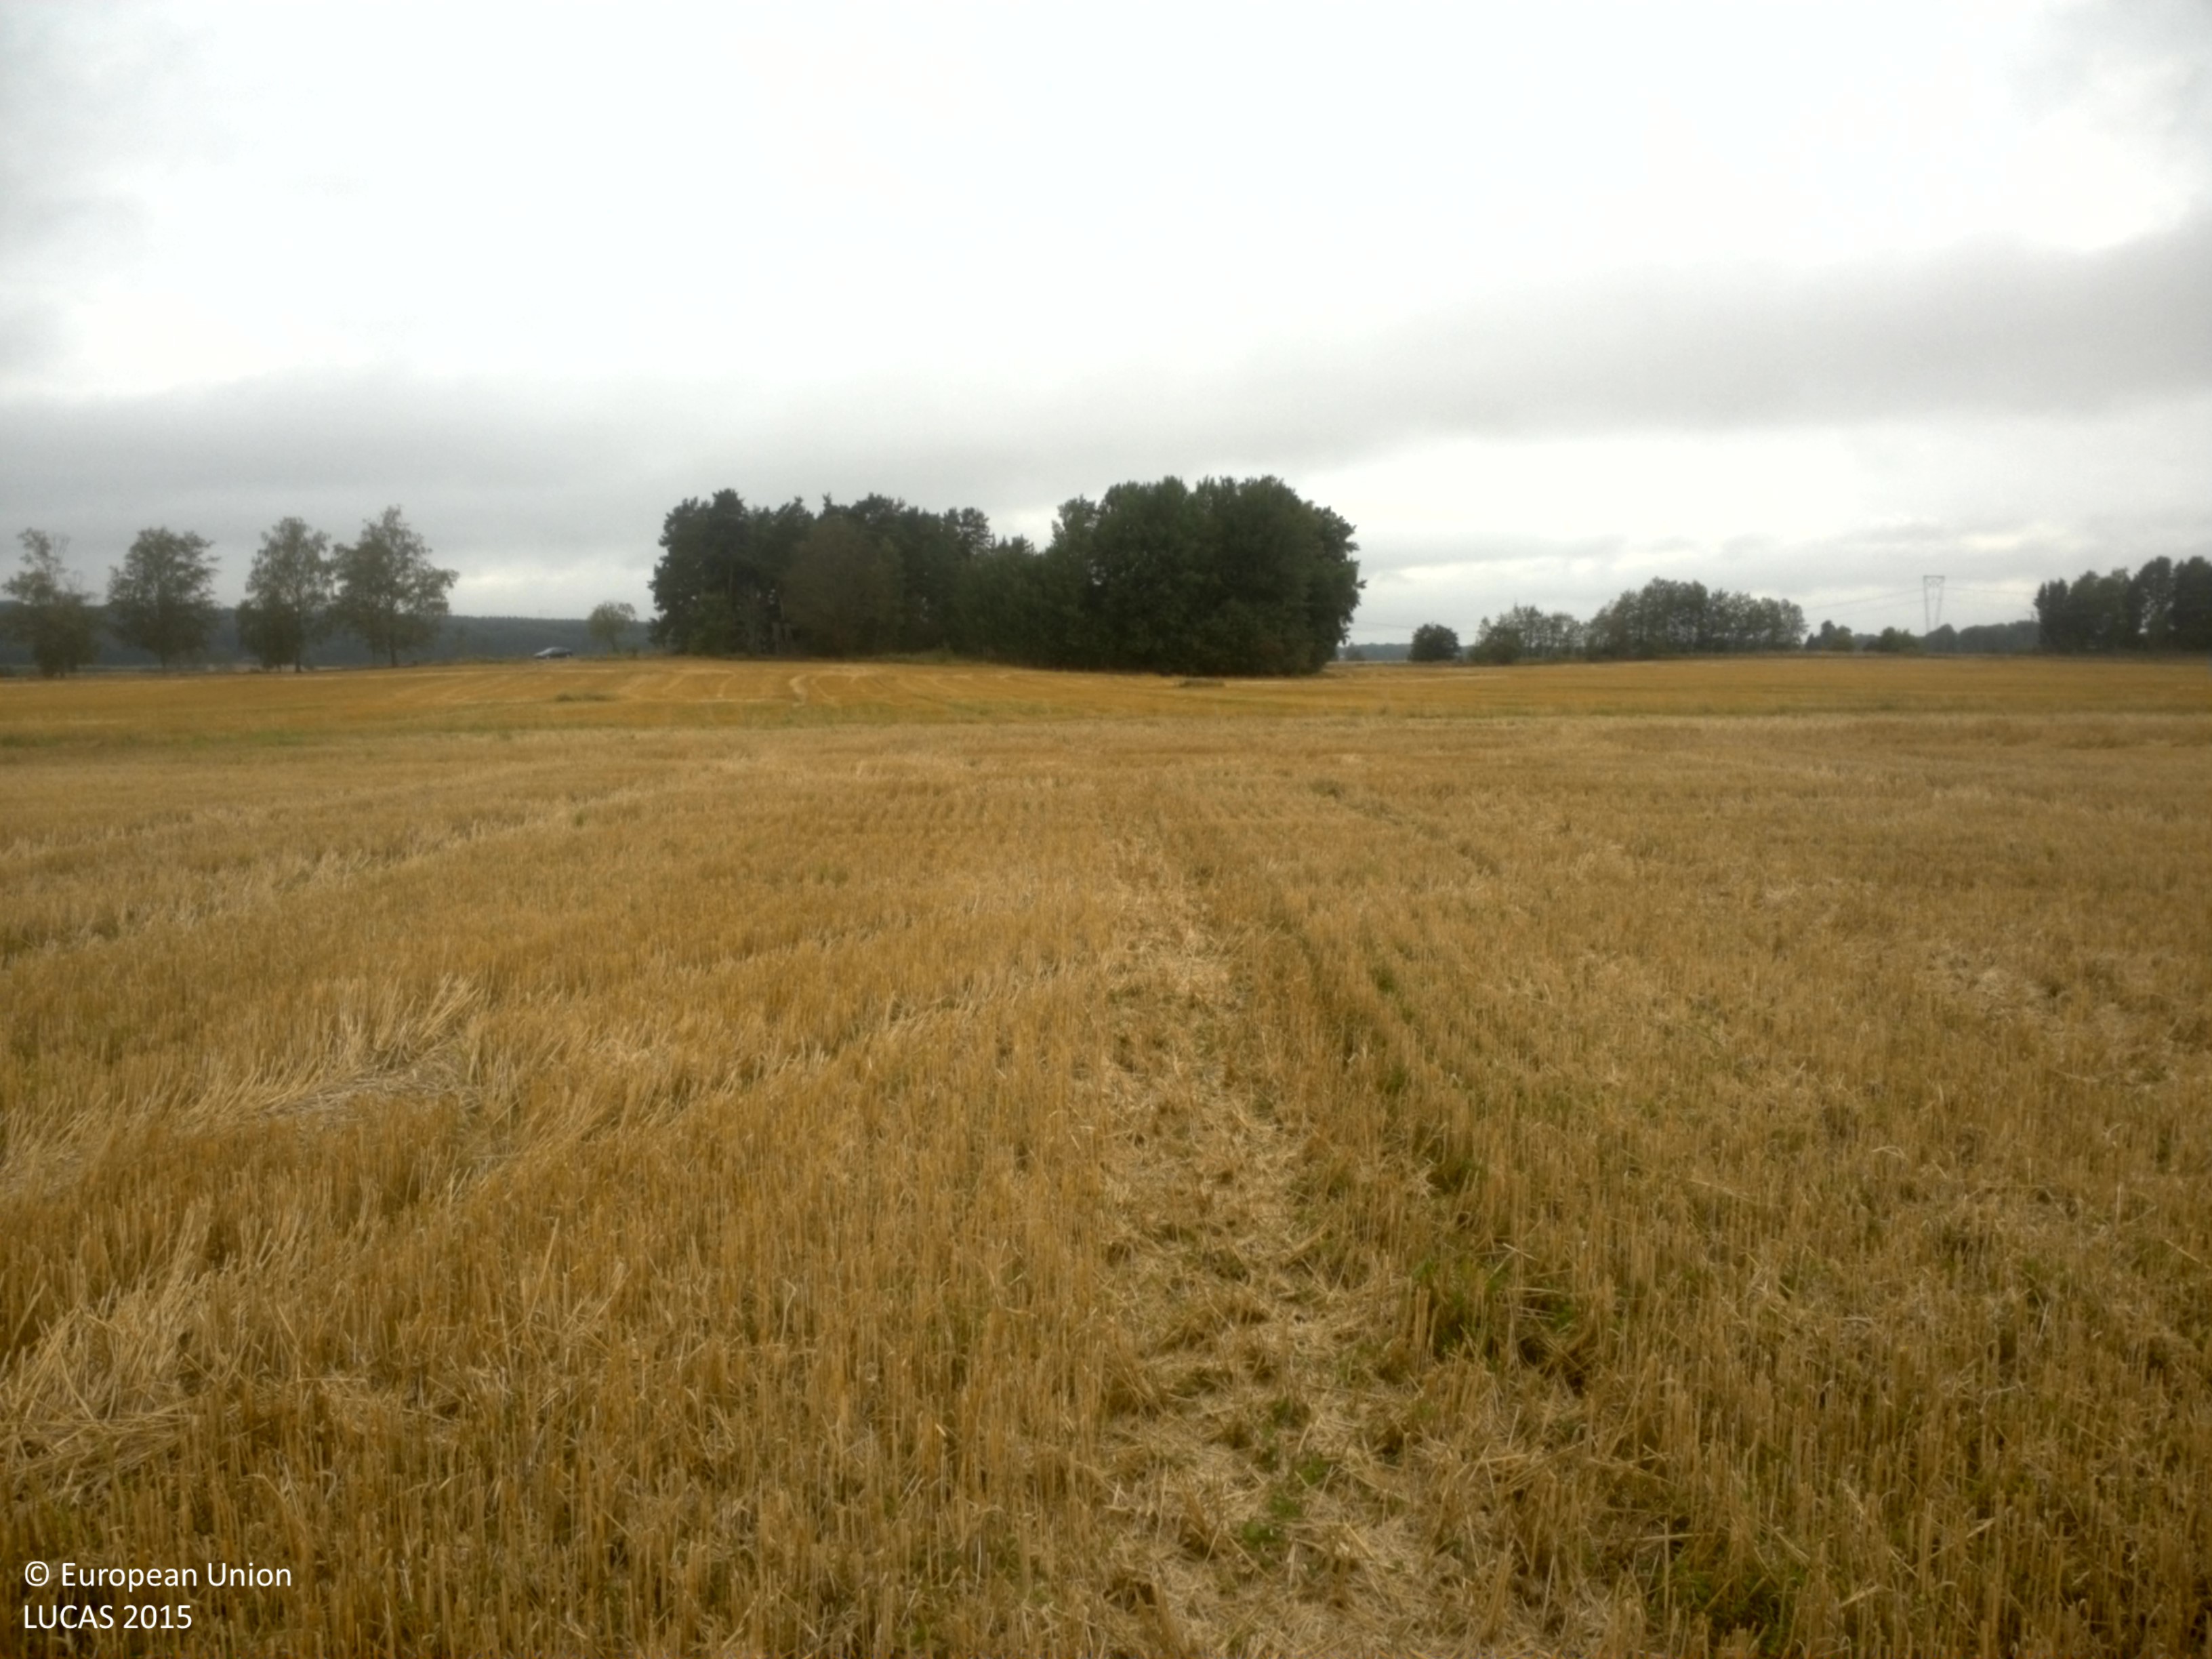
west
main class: Cropland
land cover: Common wheat
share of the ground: > 75 %
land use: Agriculture (excluding fallow land and kitchen gardens)
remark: Harvested field
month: September
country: SE
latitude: 59.4193
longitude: 15.6129
